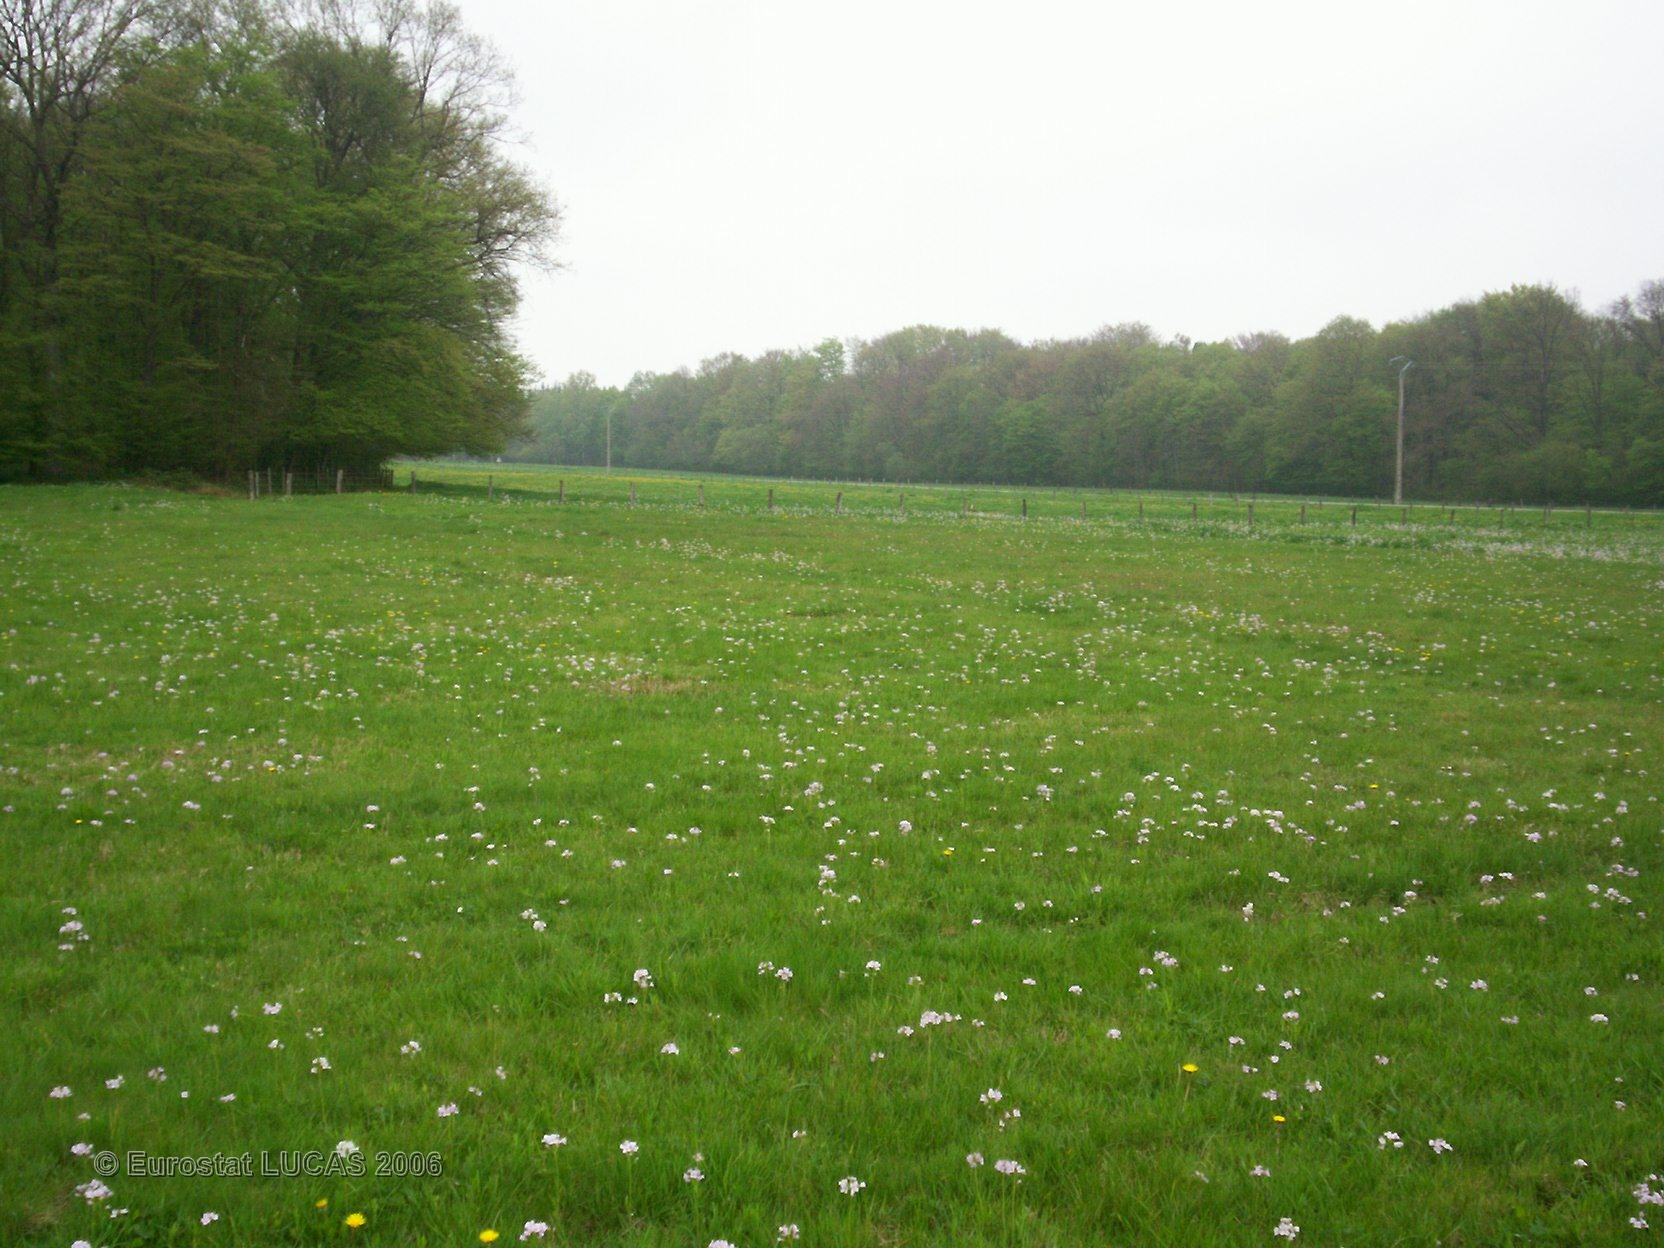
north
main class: Grassland
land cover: Grassland without tree/shrub cover
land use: Agriculture (excluding fallow land and kitchen gardens)
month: April
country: FR
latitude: 48.9136
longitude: 6.7391
